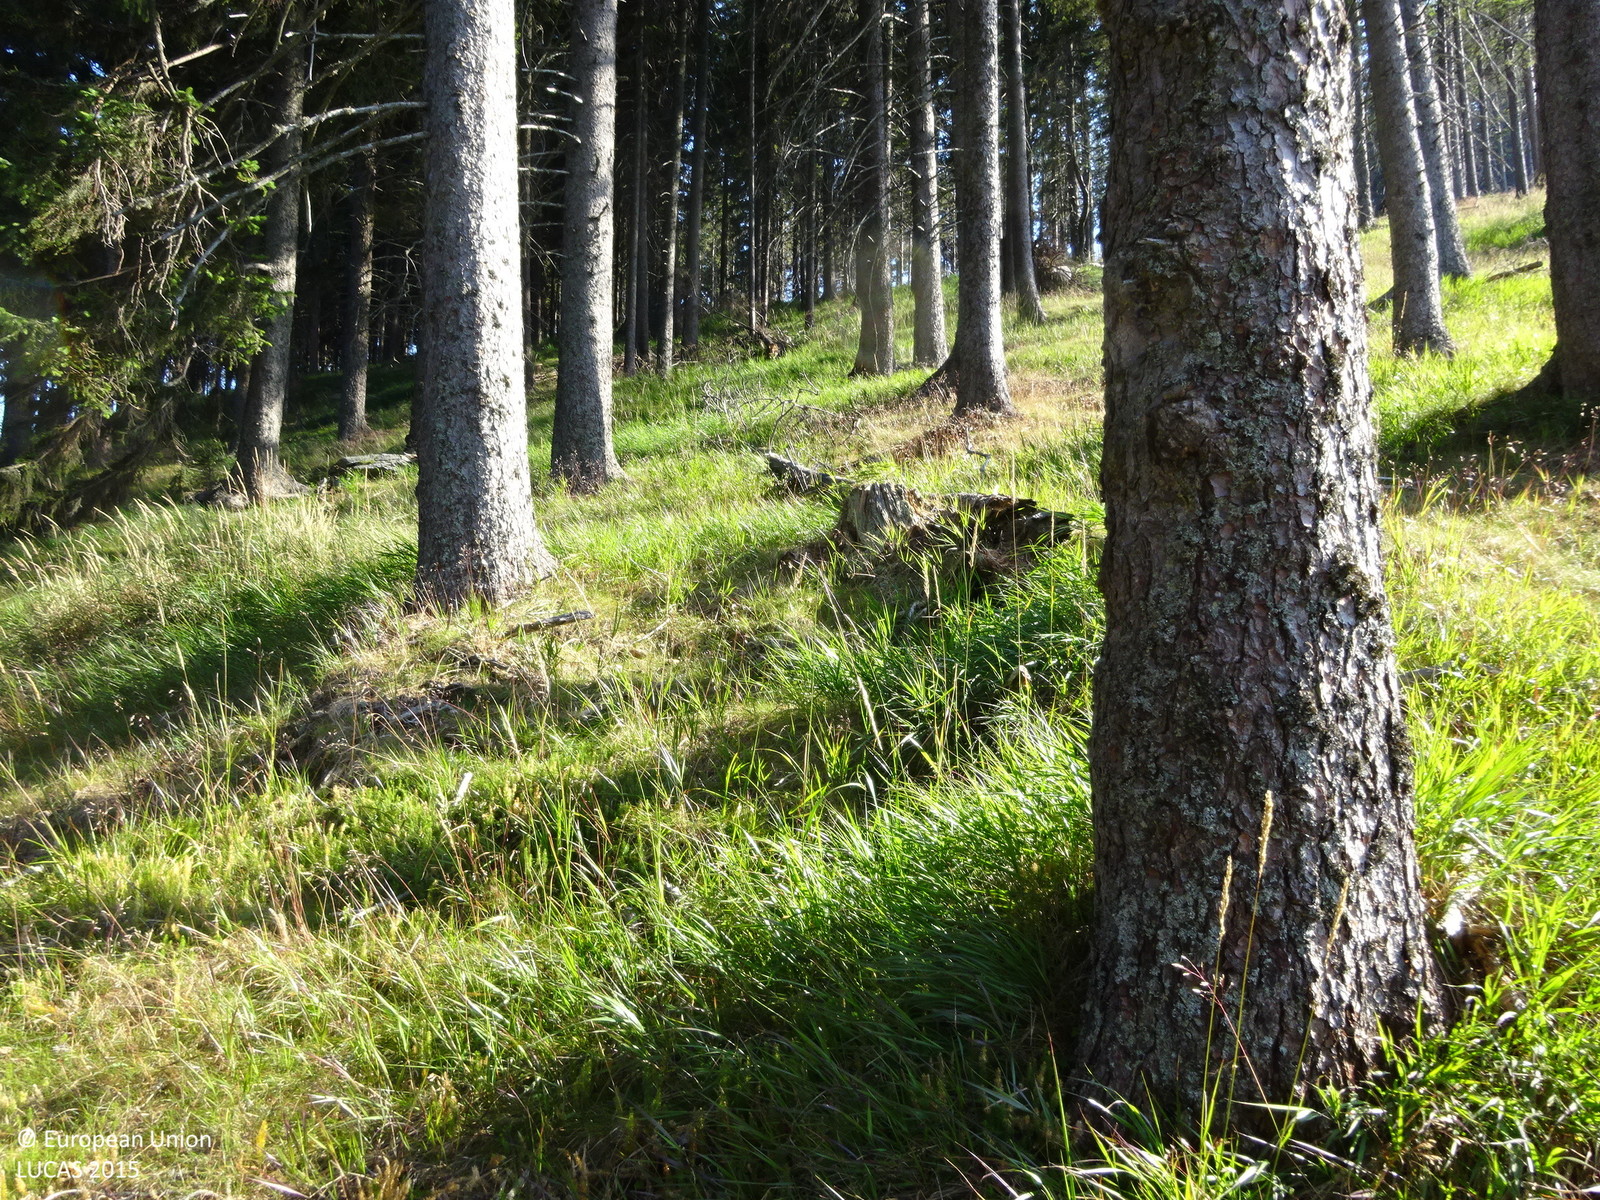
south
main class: Woodland
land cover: Spruce dominated coniferous woodland
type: alpine coniferous forest
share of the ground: > 75 %
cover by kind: coniferous forest trees 80 %, herbaceous plants 20 %
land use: Forestry
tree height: > 5 m
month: August
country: AT
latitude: 47.5192
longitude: 15.9915
